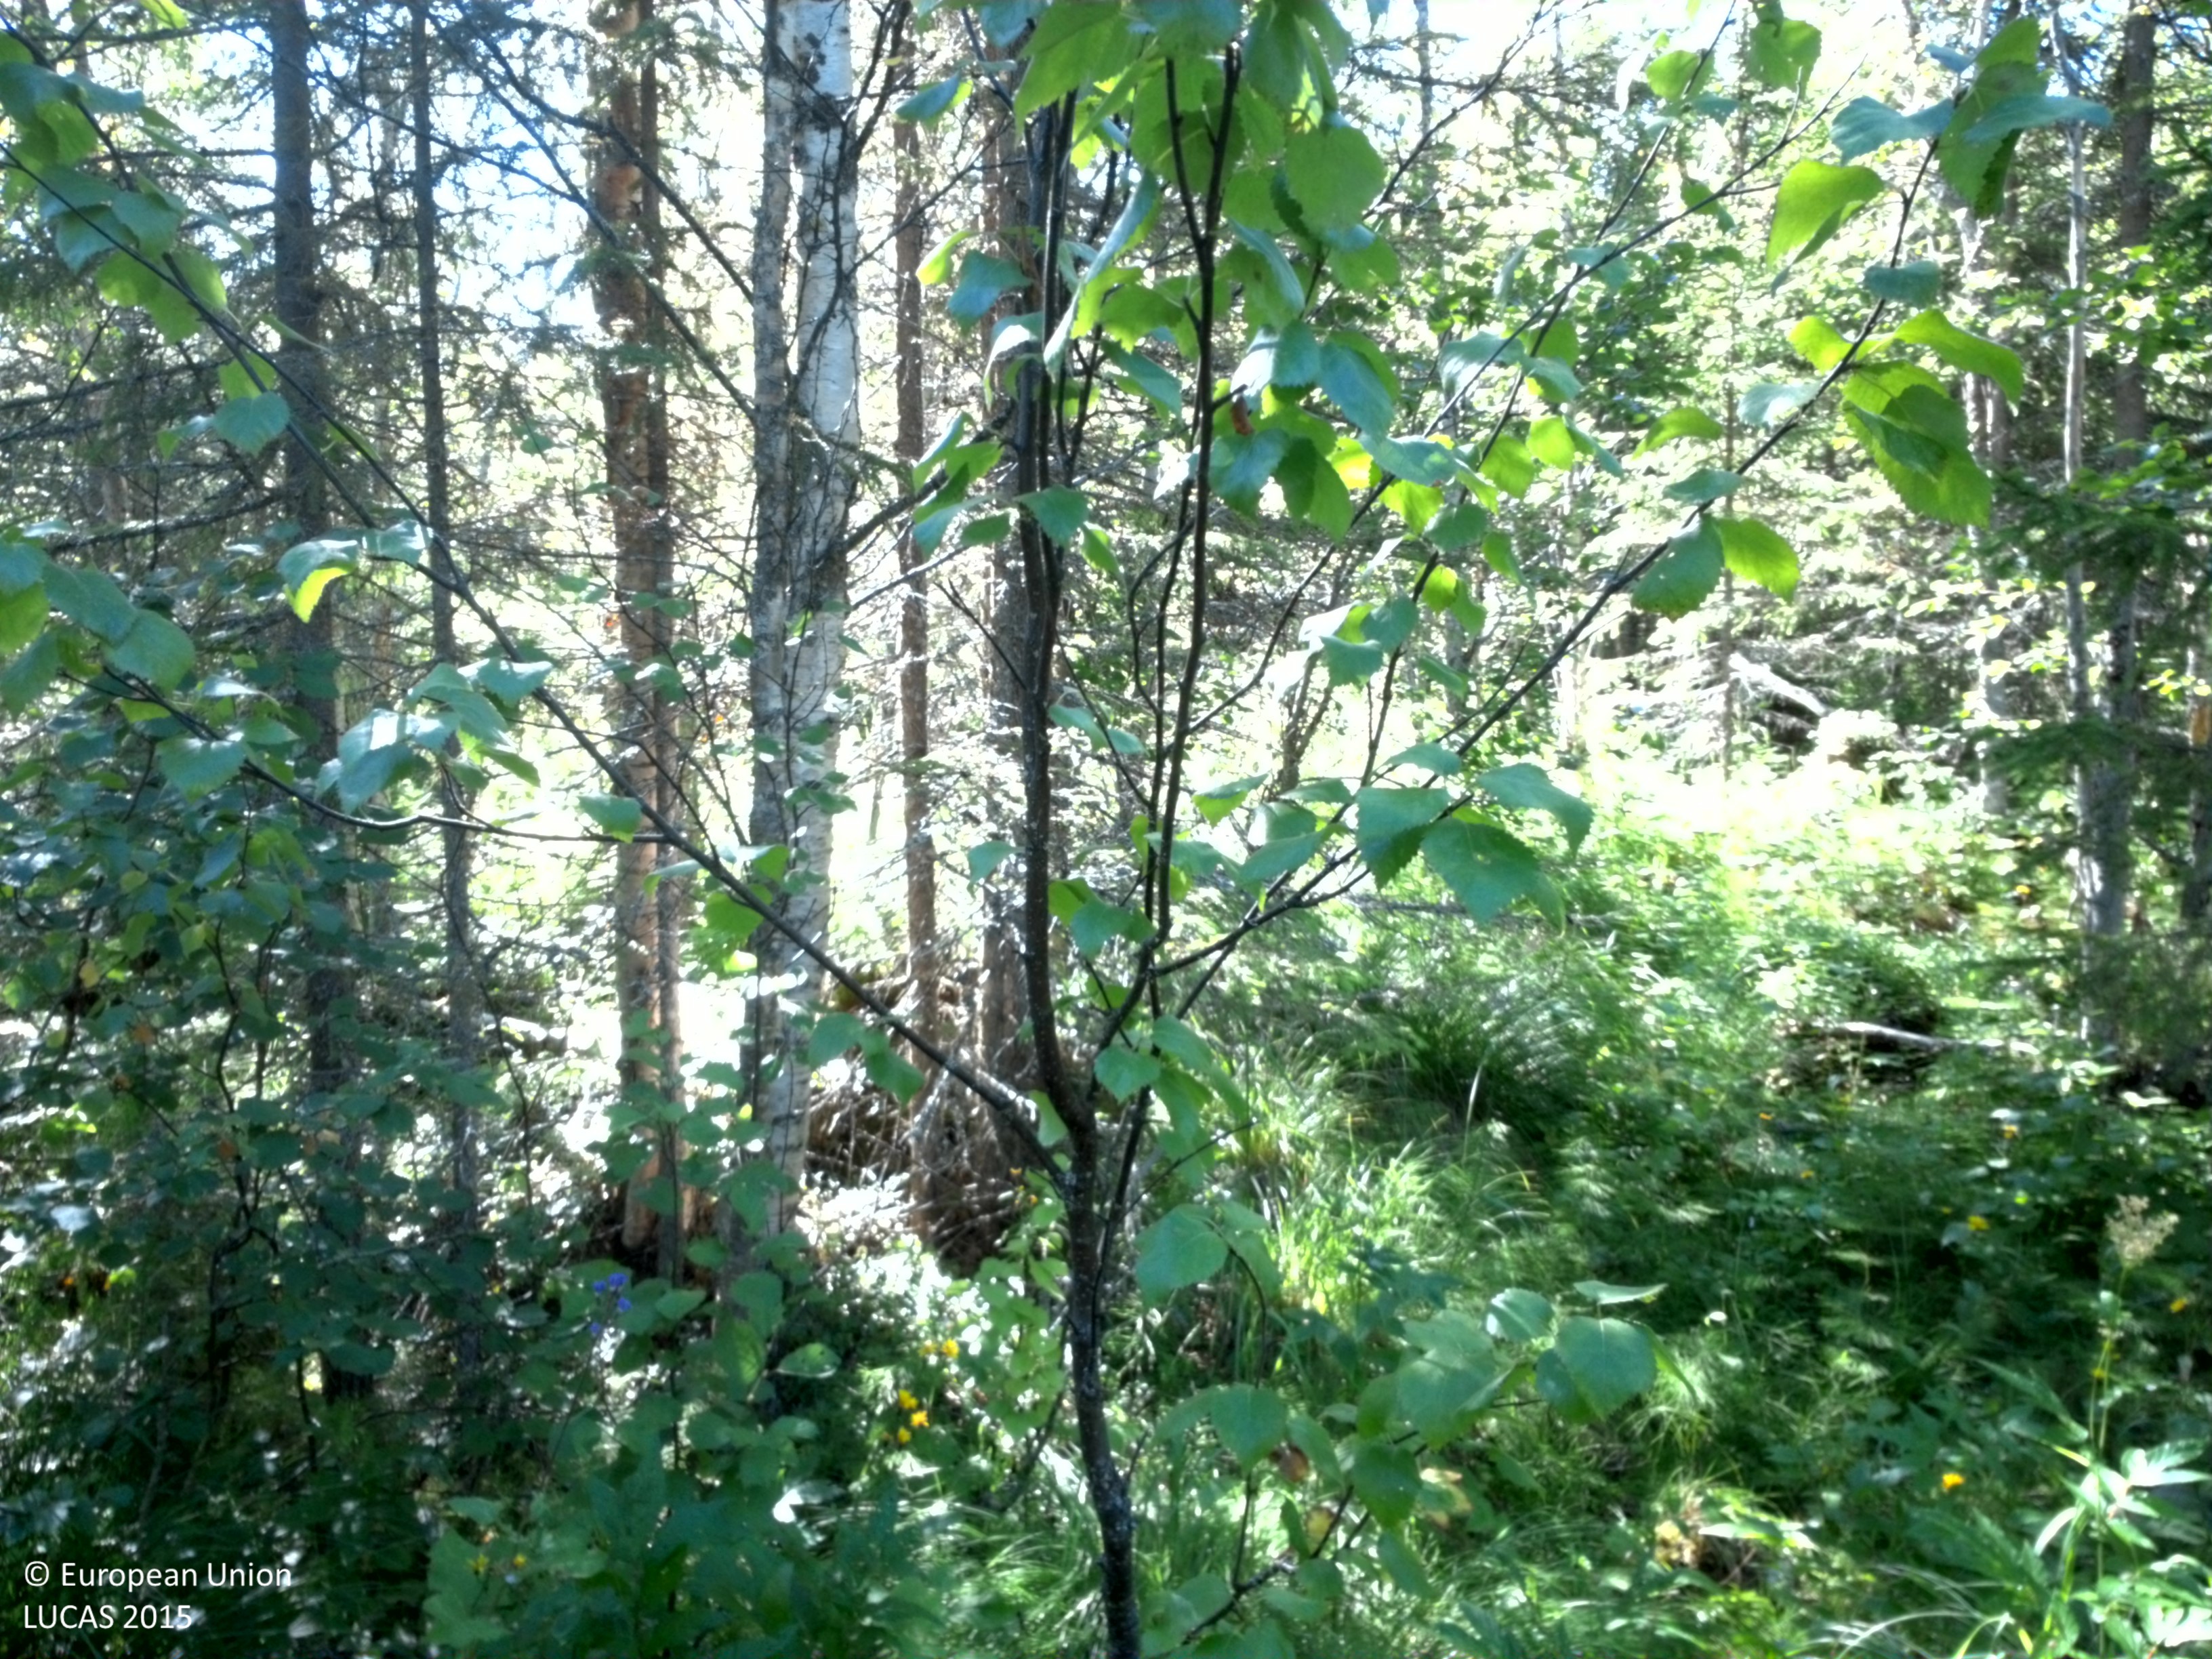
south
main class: Woodland
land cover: Spruce dominated mixed woodland
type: boreal forest
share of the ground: 25 - 50 %
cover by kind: herbaceous plants 50 %, coniferous forest trees 25 %, broadleaved forest trees 20 %, shrubs 5 %
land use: Forestry
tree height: > 5 m
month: August
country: SE
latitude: 64.7331
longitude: 16.1194
